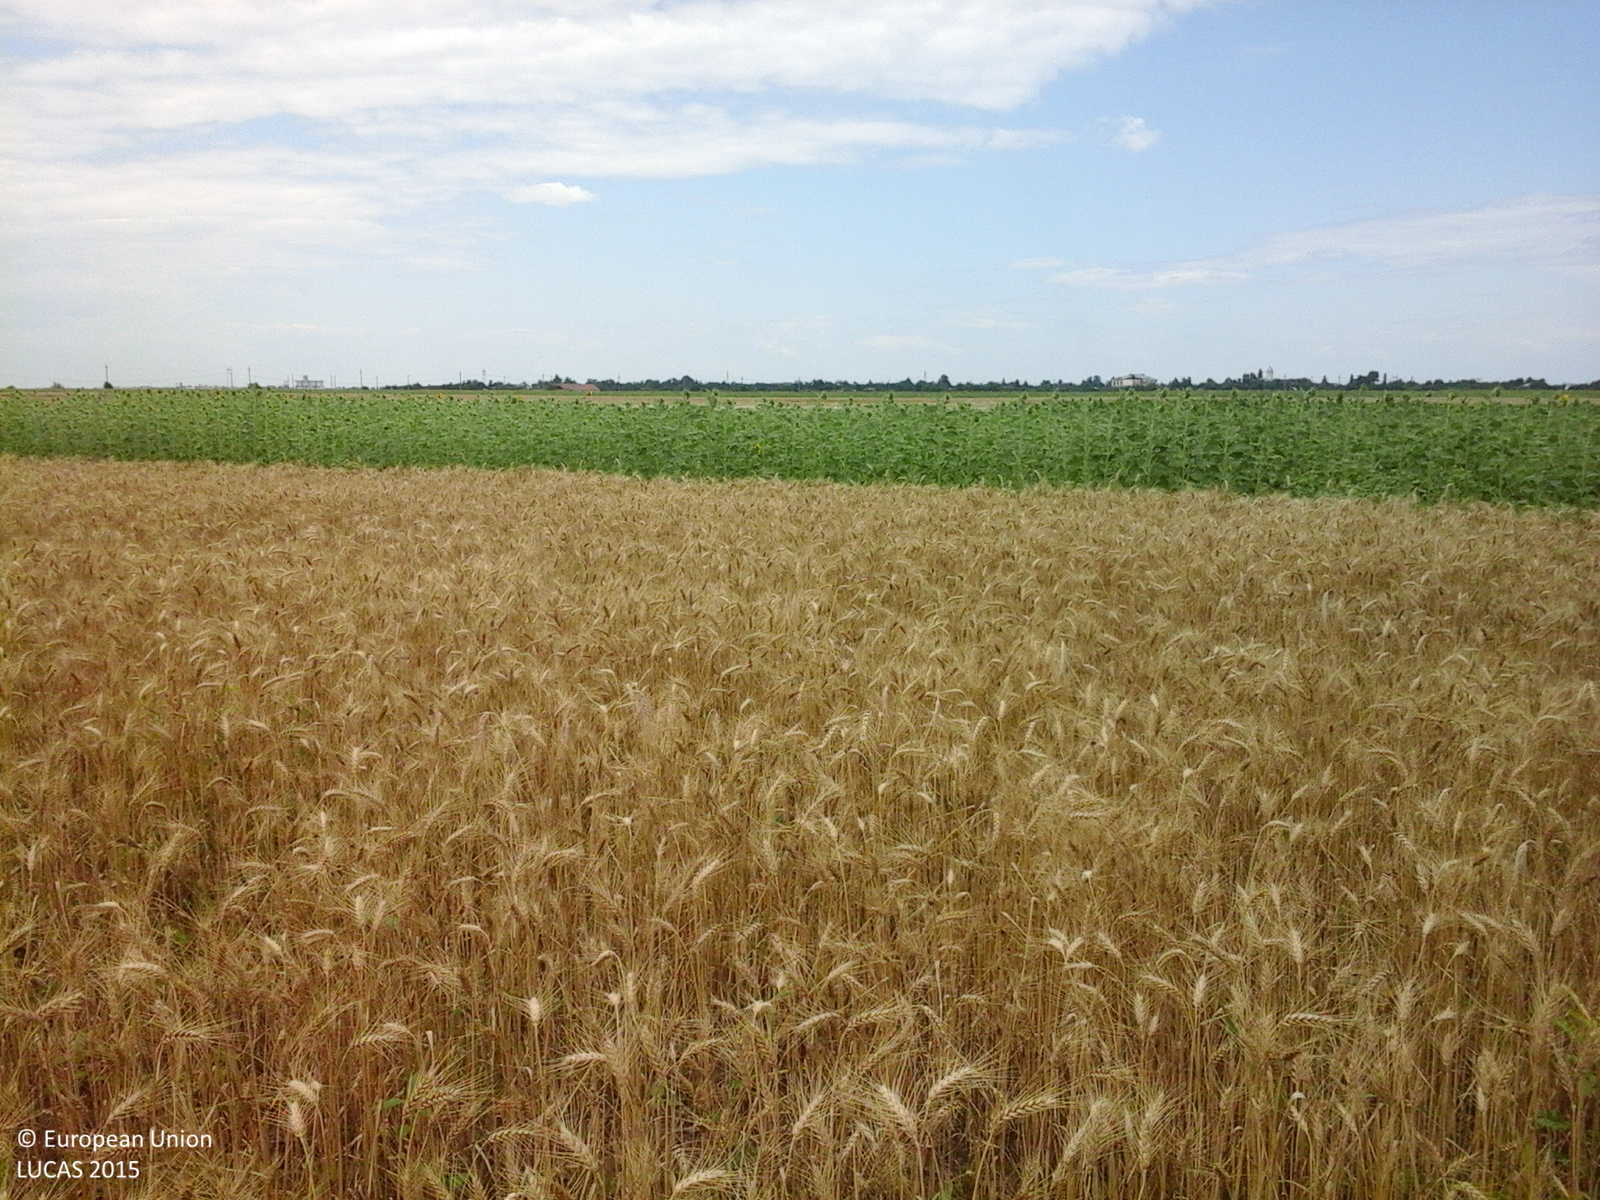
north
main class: Cropland
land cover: Common wheat
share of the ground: > 75 %
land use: Agriculture (excluding fallow land and kitchen gardens)
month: July
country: RO
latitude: 44.2331
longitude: 25.5525
